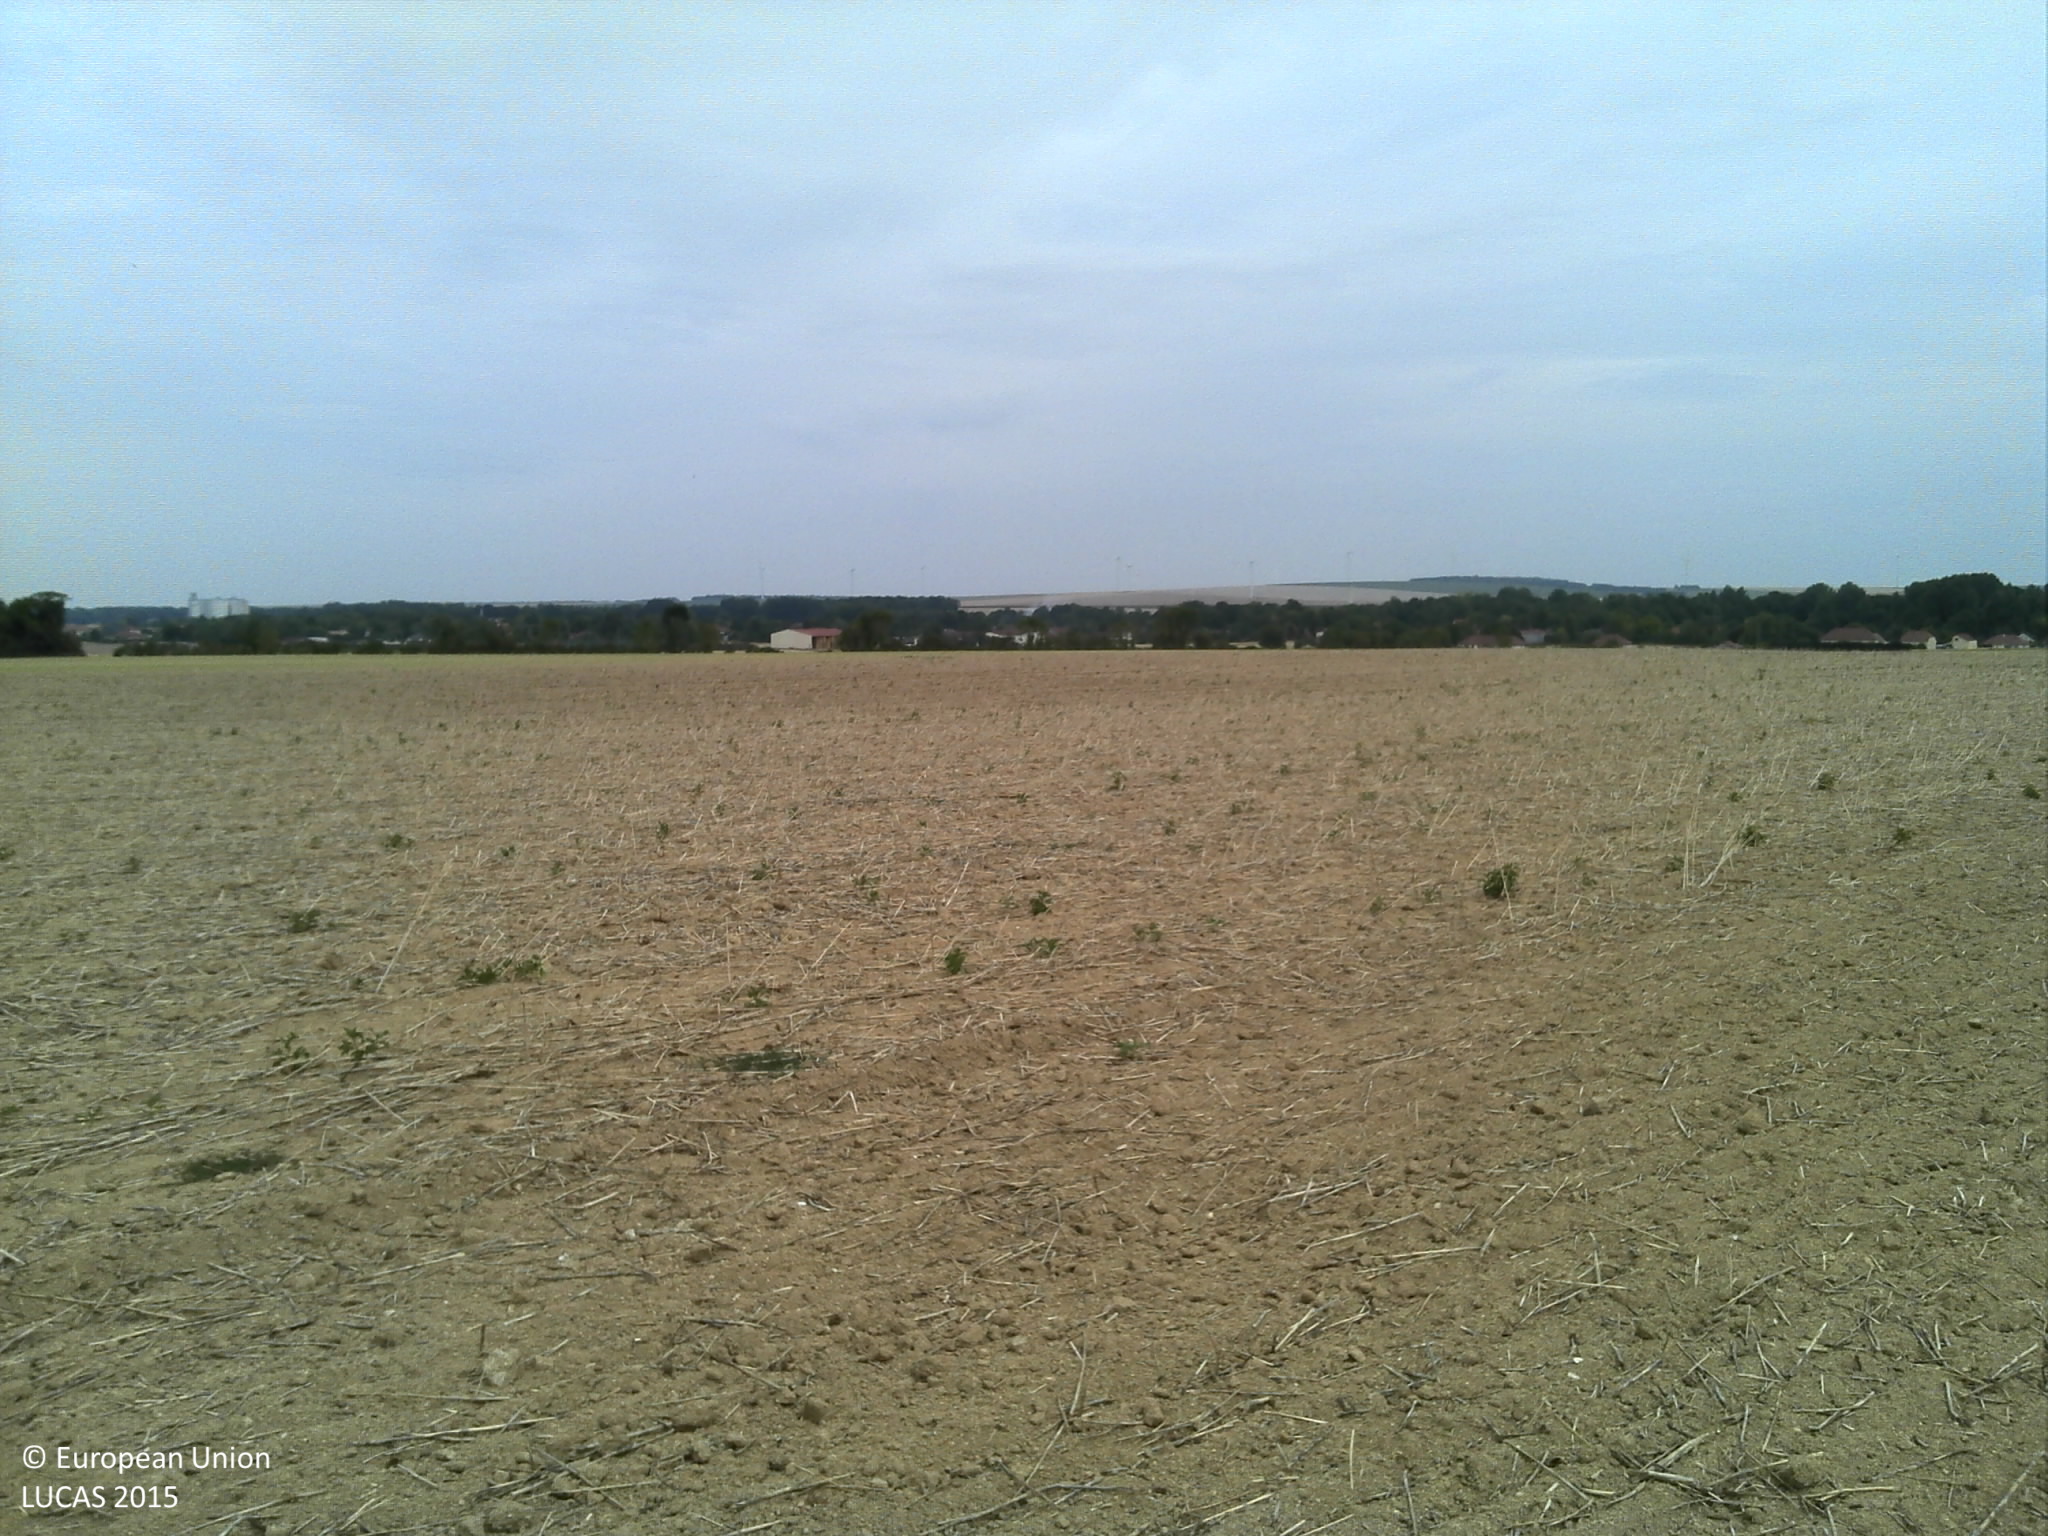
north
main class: Cropland
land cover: Other fibre and oleaginous crops
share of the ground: 10 - 25 %
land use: Agriculture (excluding fallow land and kitchen gardens)
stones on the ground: < 10 %
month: August
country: FR
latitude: 48.3943
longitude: 4.1755
